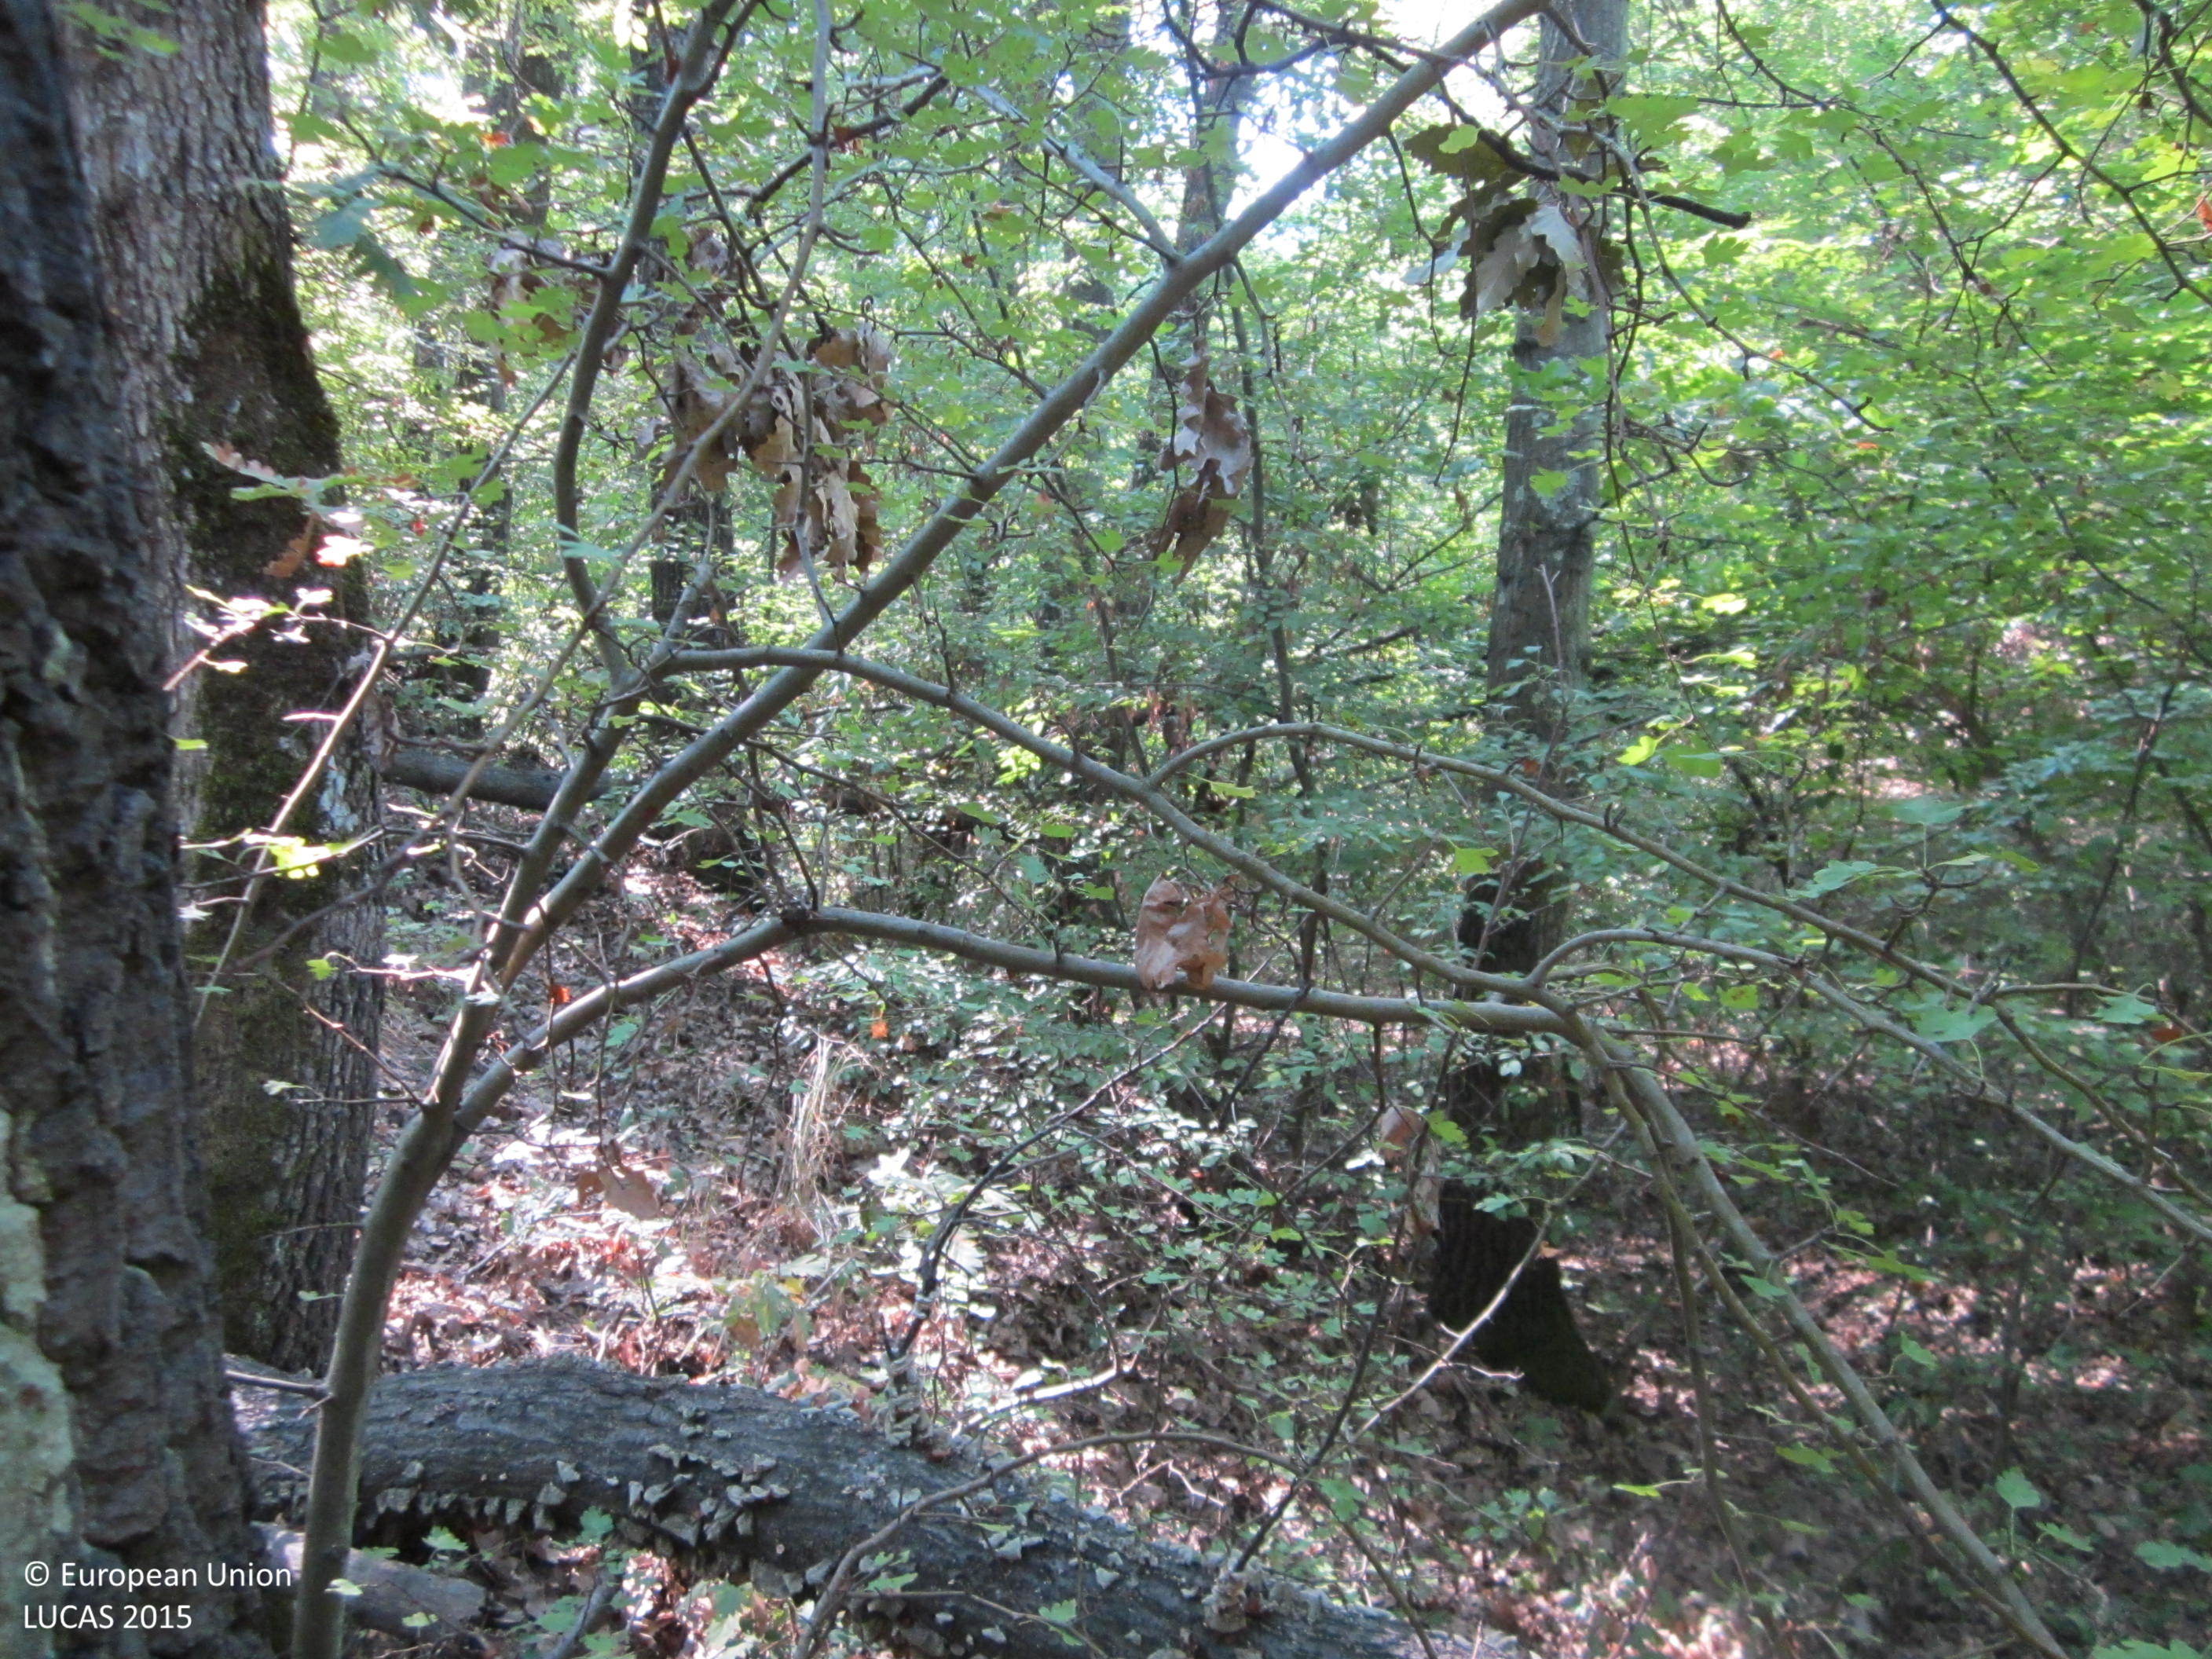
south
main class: Woodland
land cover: Broadleaved woodland
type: mesophytic deciduous forest
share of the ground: > 75 %
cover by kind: broadleaved forest trees 95 %, unconsolidated bare surface 5 %
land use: Forestry
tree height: > 5 m
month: September
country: BG
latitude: 42.8407
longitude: 26.9056
